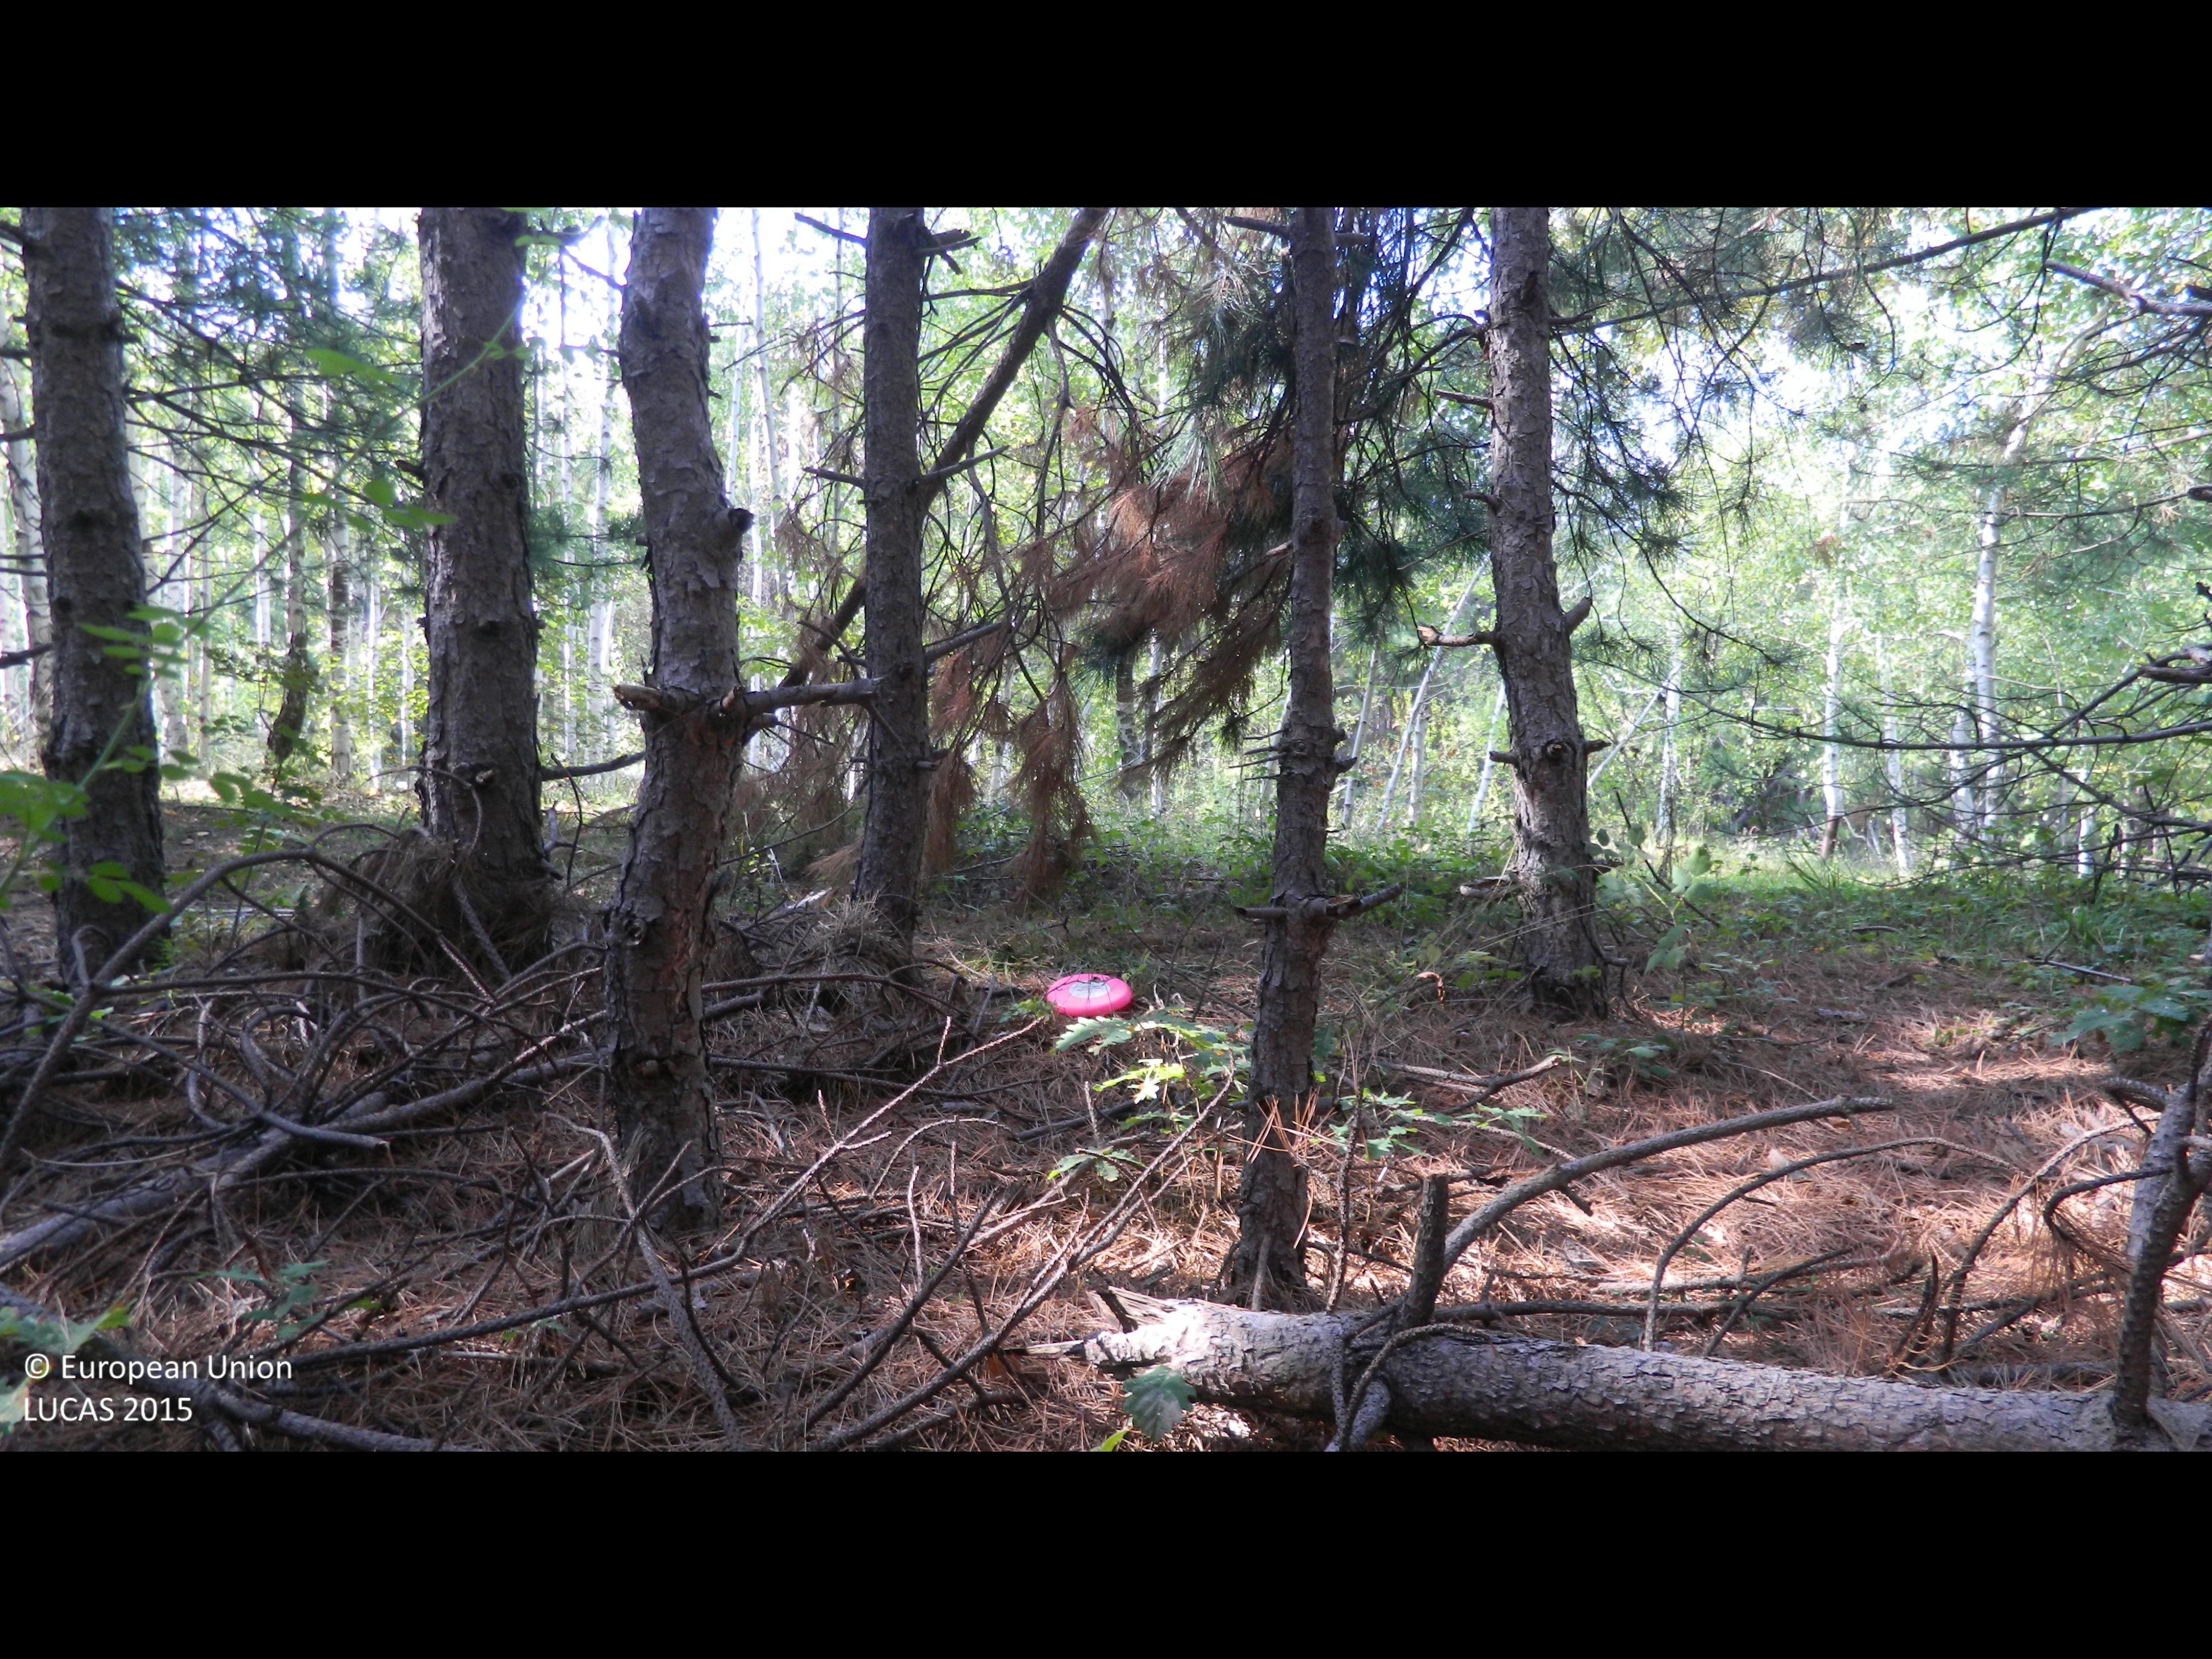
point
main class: Woodland
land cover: Pine dominated coniferous woodland
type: hemiboreal forest and nemoral coniferous forest and mixed broadleaved-coniferous forest
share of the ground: > 75 %
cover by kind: coniferous forest trees 95 %, broadleaved forest trees 5 %
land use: Forestry
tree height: > 5 m
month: October
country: BG
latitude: 41.7948
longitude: 25.3049
